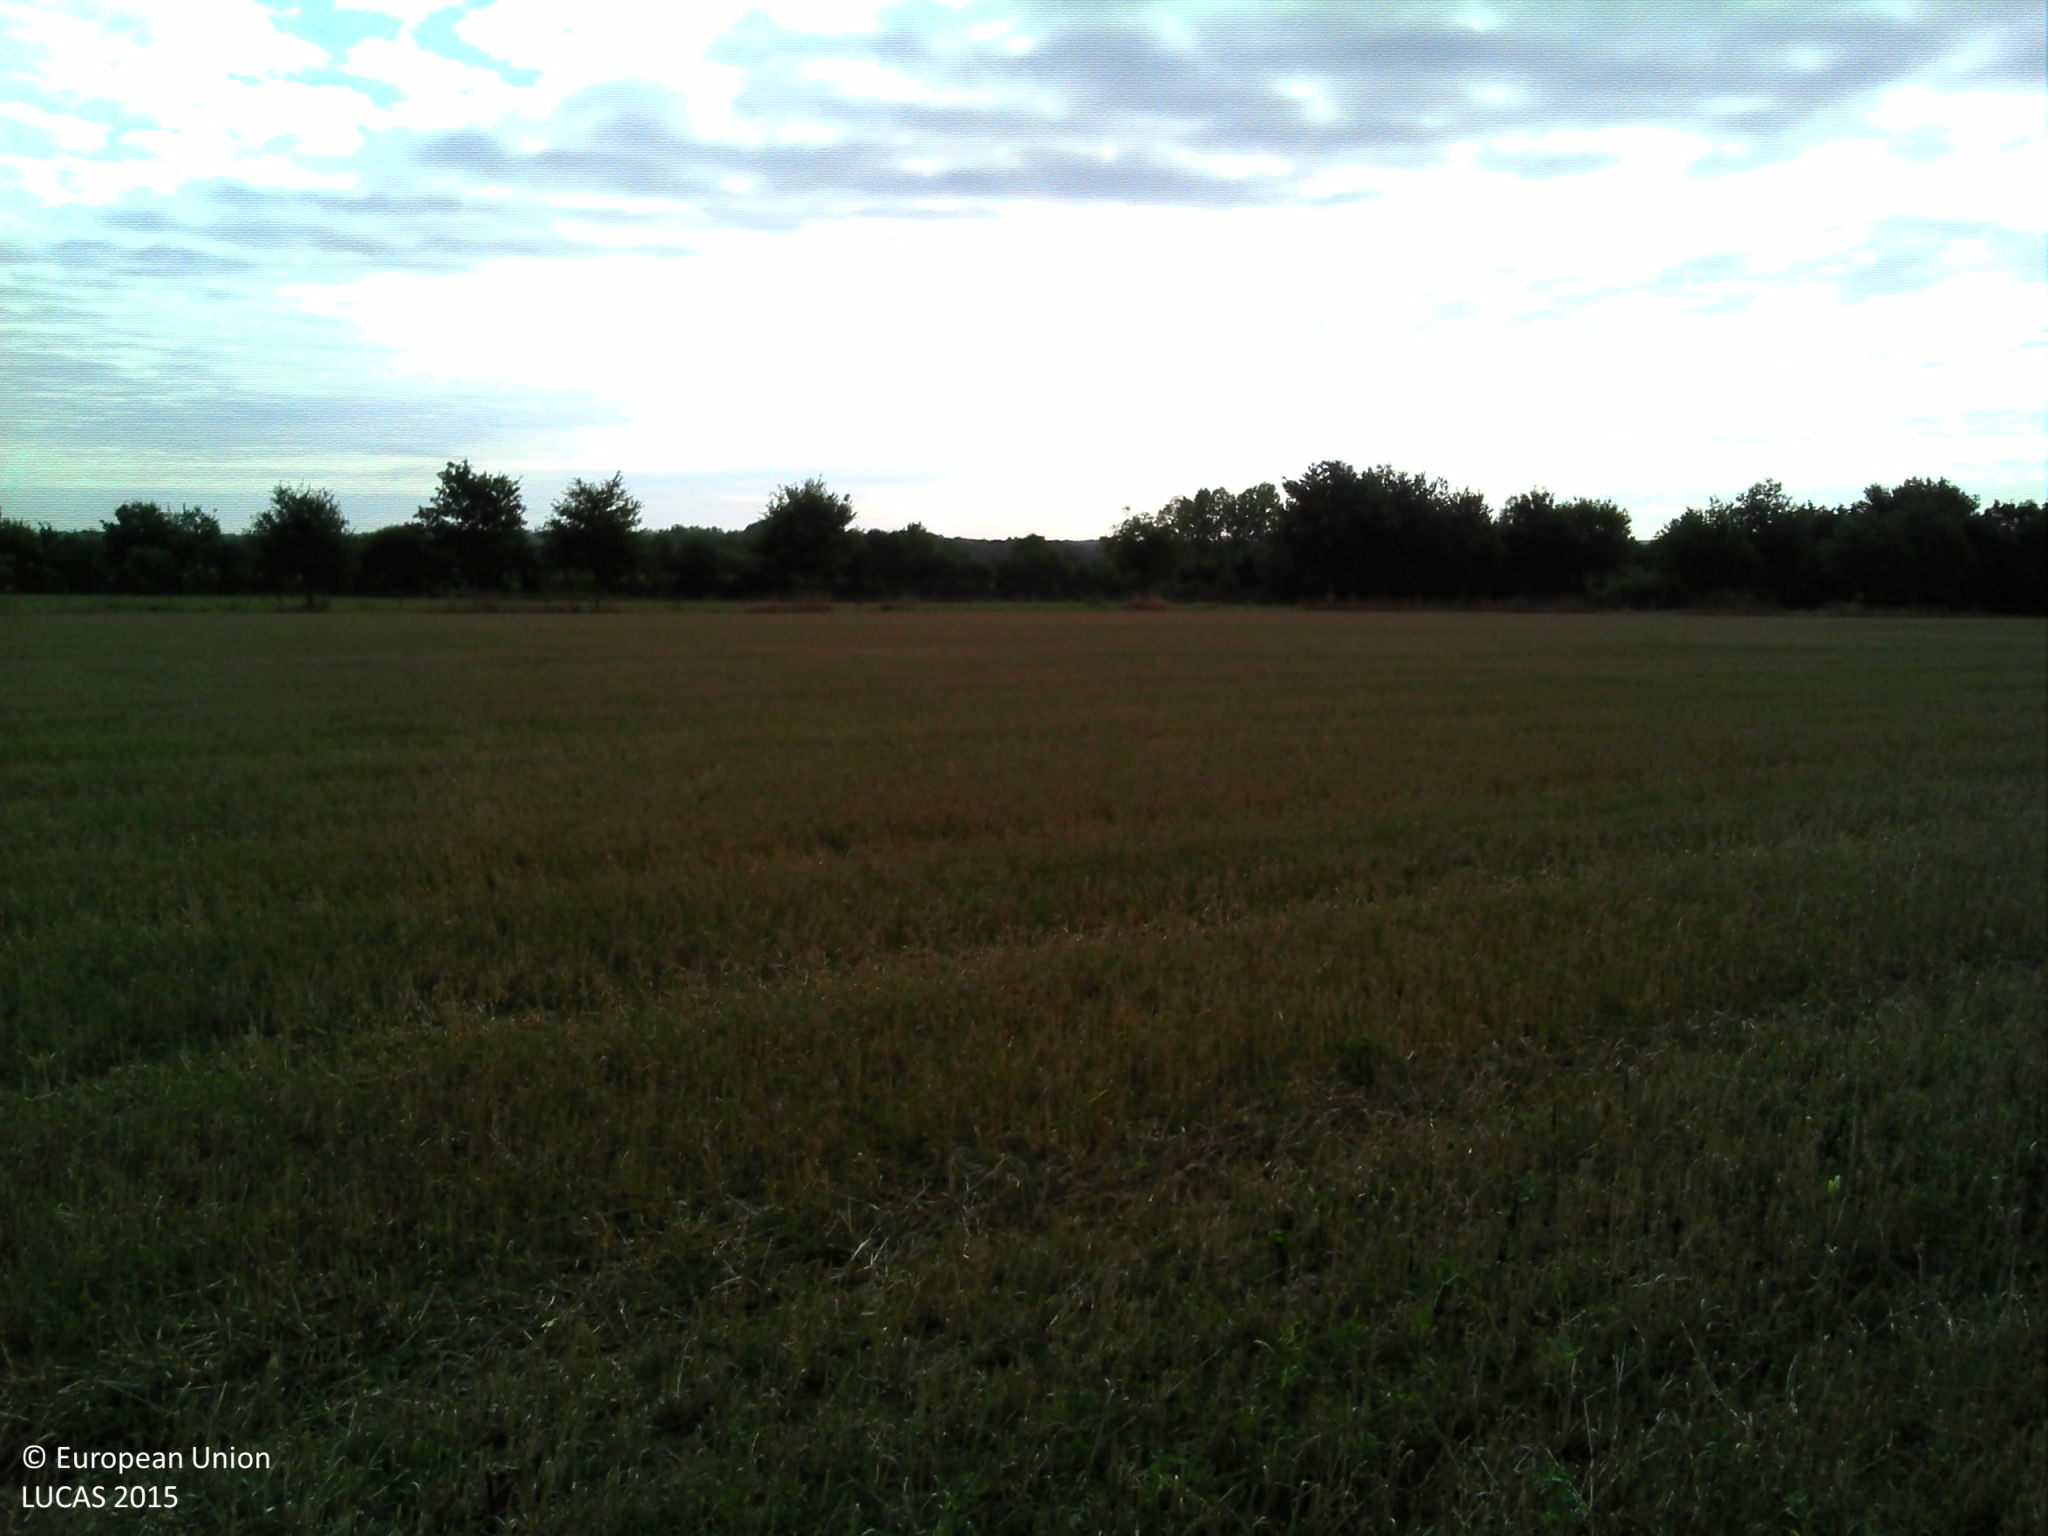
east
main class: Cropland
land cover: Common wheat
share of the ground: > 75 %
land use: Agriculture (excluding fallow land and kitchen gardens)
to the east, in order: Common wheat; Lines of trees; Tracks; Ditches and canals; Fences; Temporary grasslands; Fences; Shrubland without tree cover; Tracks; Fences; Broadleaved woodland; Maize
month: August
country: FR
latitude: 47.0225
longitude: -1.4733
